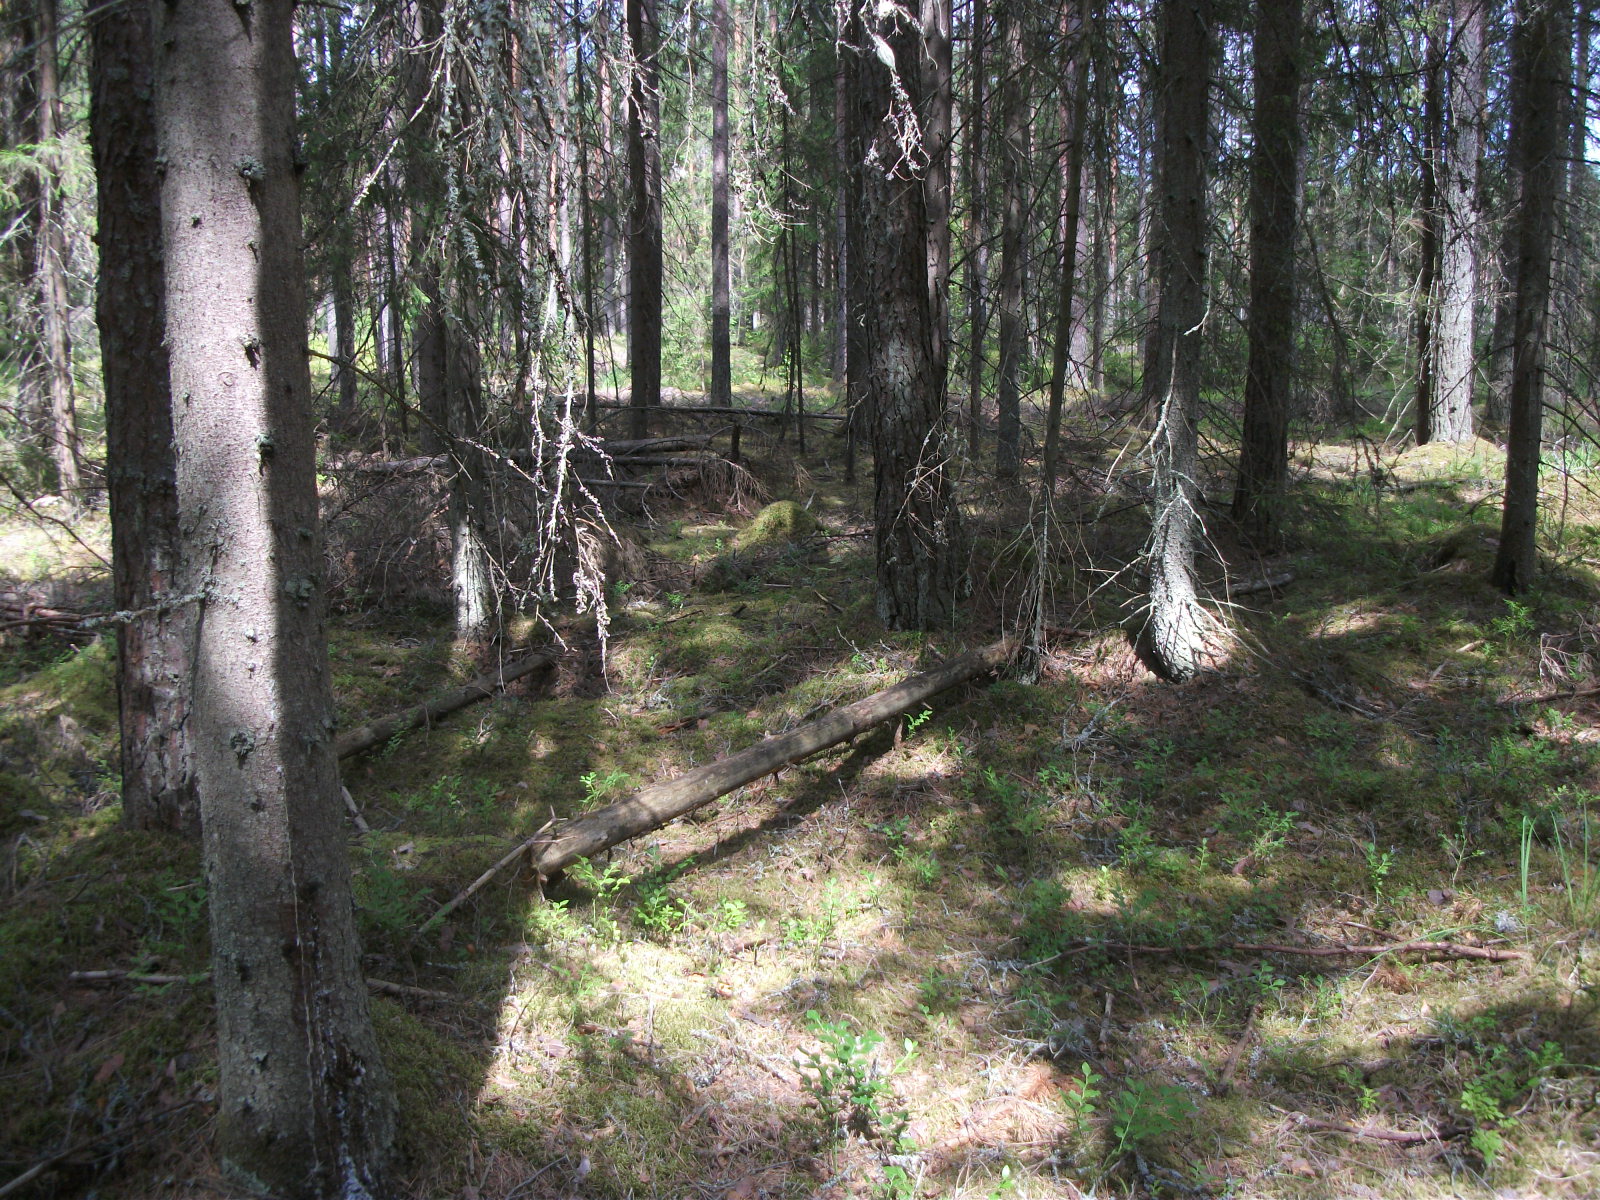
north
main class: Woodland
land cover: Other coniferous woodland
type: hemiboreal forest and nemoral coniferous forest and mixed broadleaved-coniferous forest
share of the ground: > 75 %
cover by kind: coniferous forest trees 85 %, lichens and mosses 10 %, shrubs 5 %
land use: Forestry
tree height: > 5 m
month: July
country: LV
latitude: 57.0818
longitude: 26.3253
